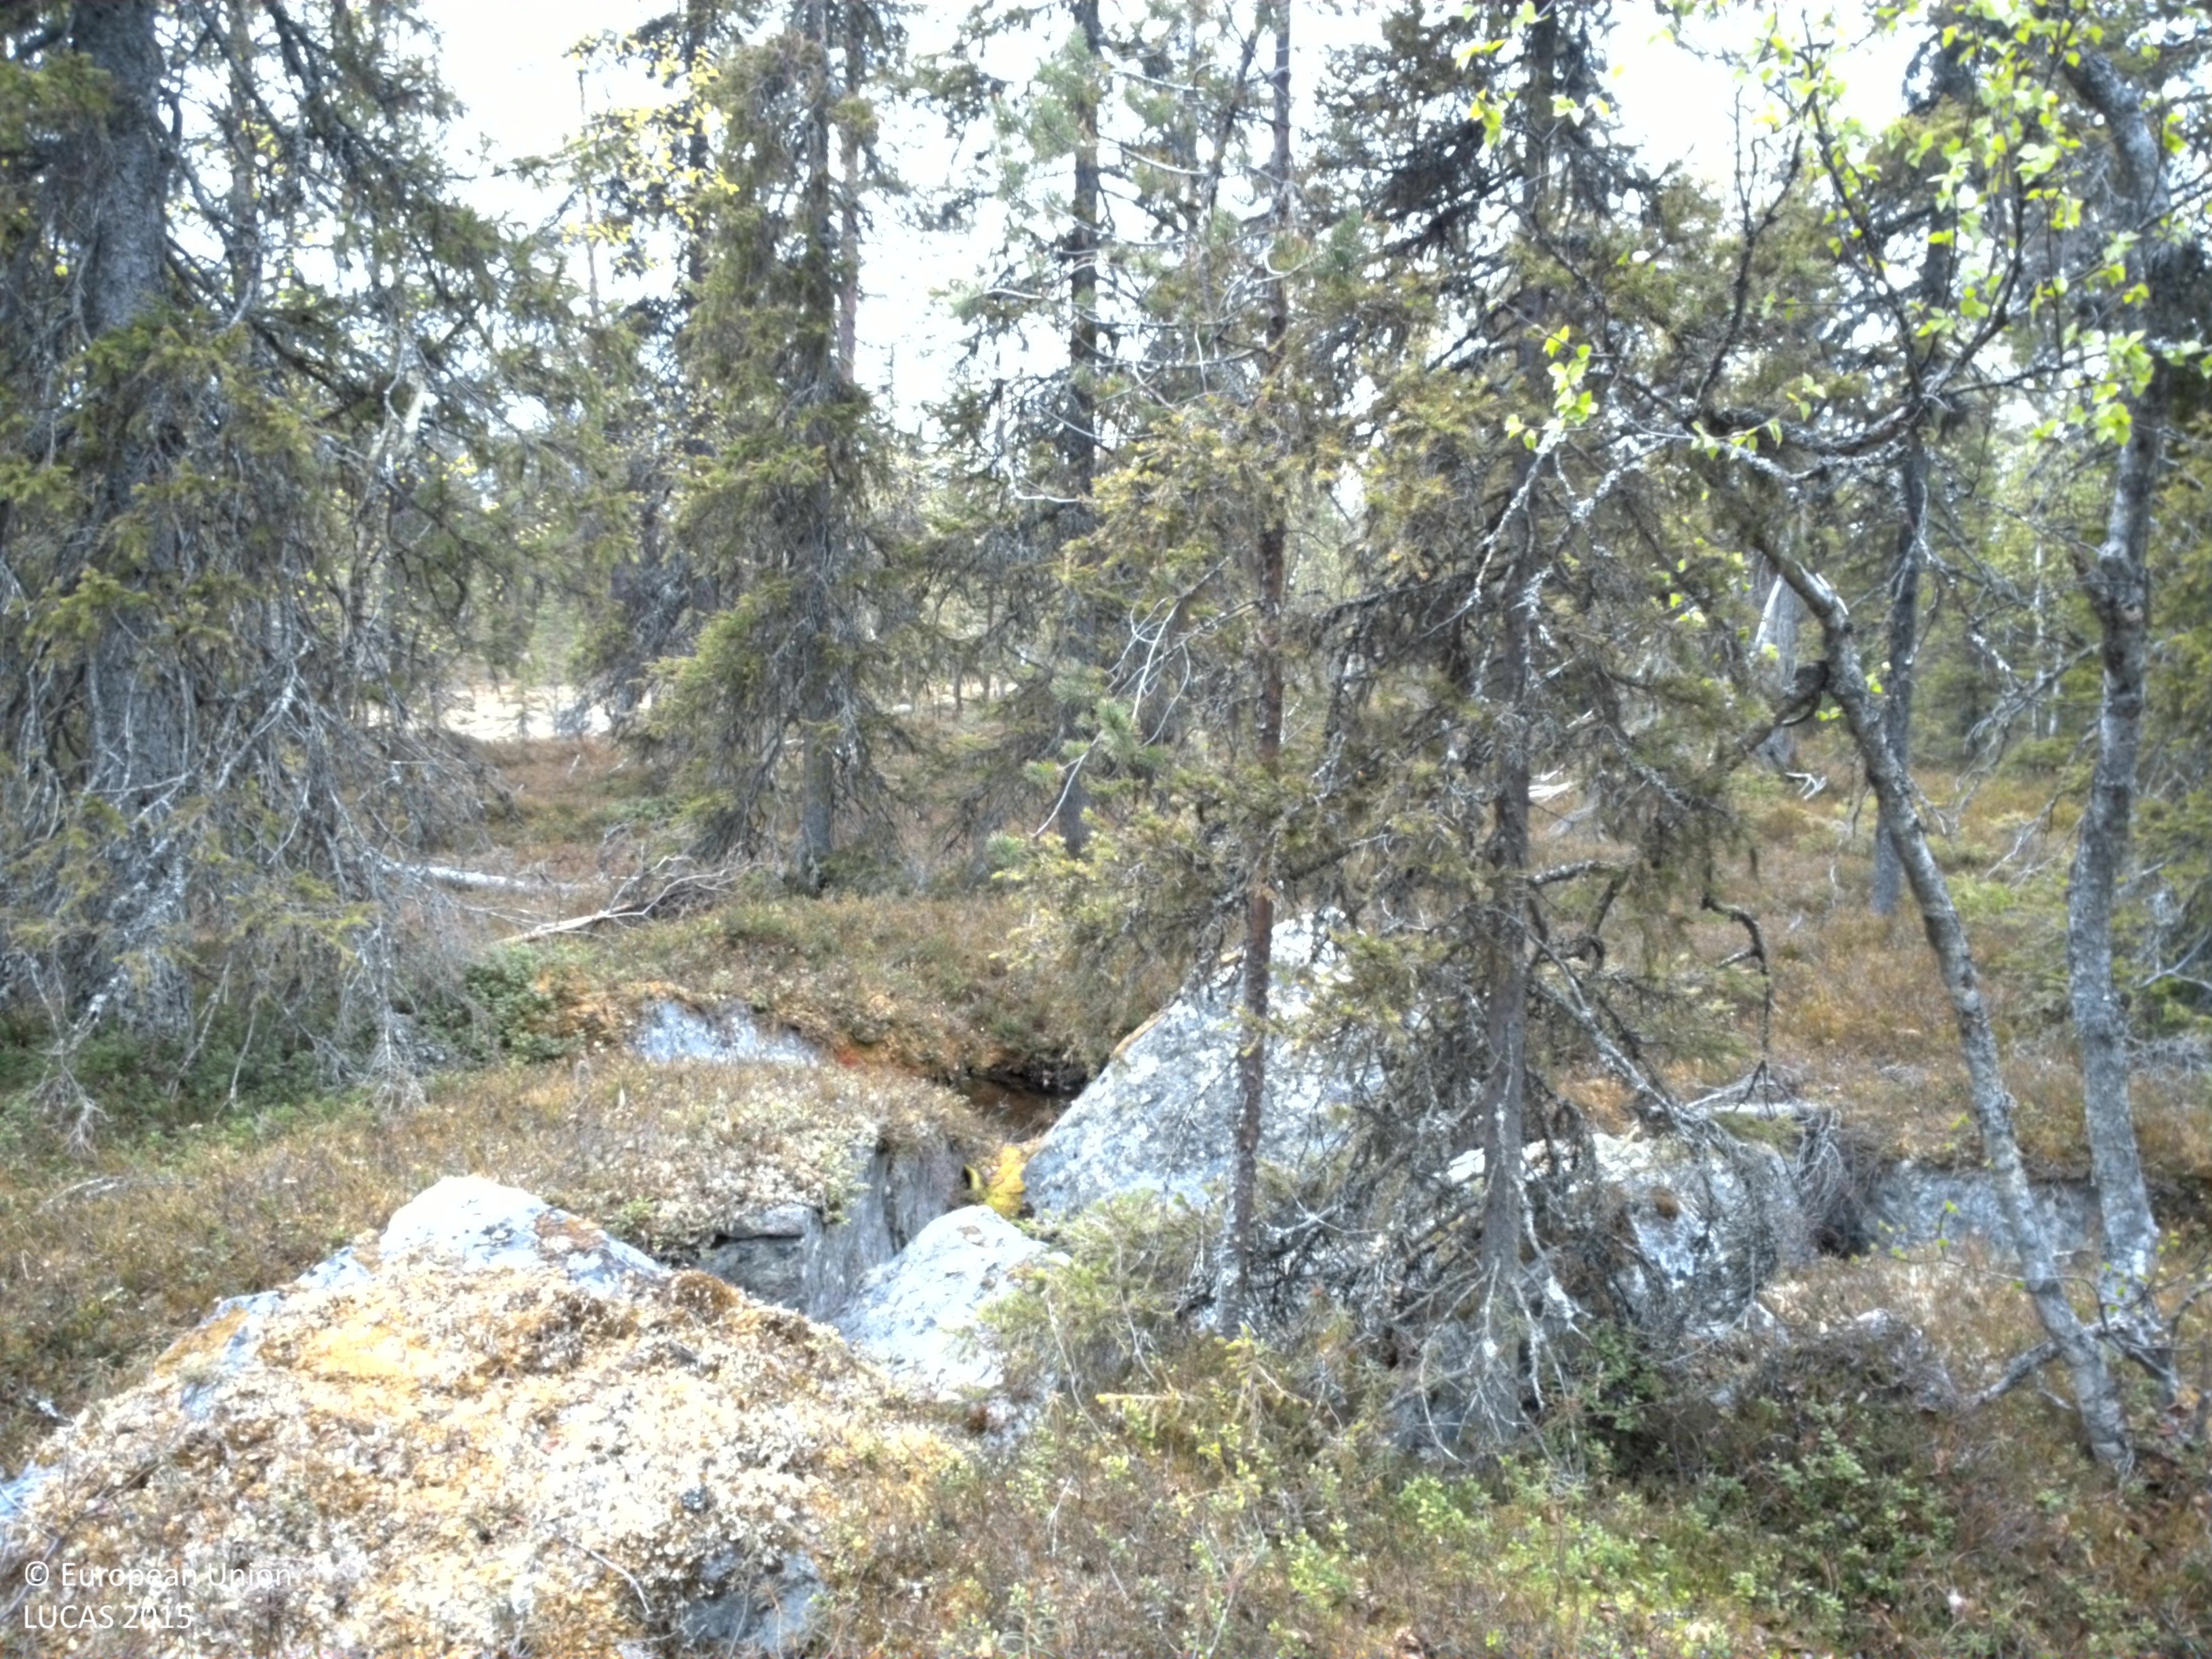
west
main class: Woodland
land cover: Spruce dominated coniferous woodland
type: boreal forest
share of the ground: 10 - 25 %
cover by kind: shrubs 70 %, coniferous forest trees 20 %, broadleaved forest trees 5 %, consolidated bare surface 5 %
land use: Forestry
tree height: > 5 m
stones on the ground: > 50 %
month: June
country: SE
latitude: 66.1025
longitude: 18.7817
